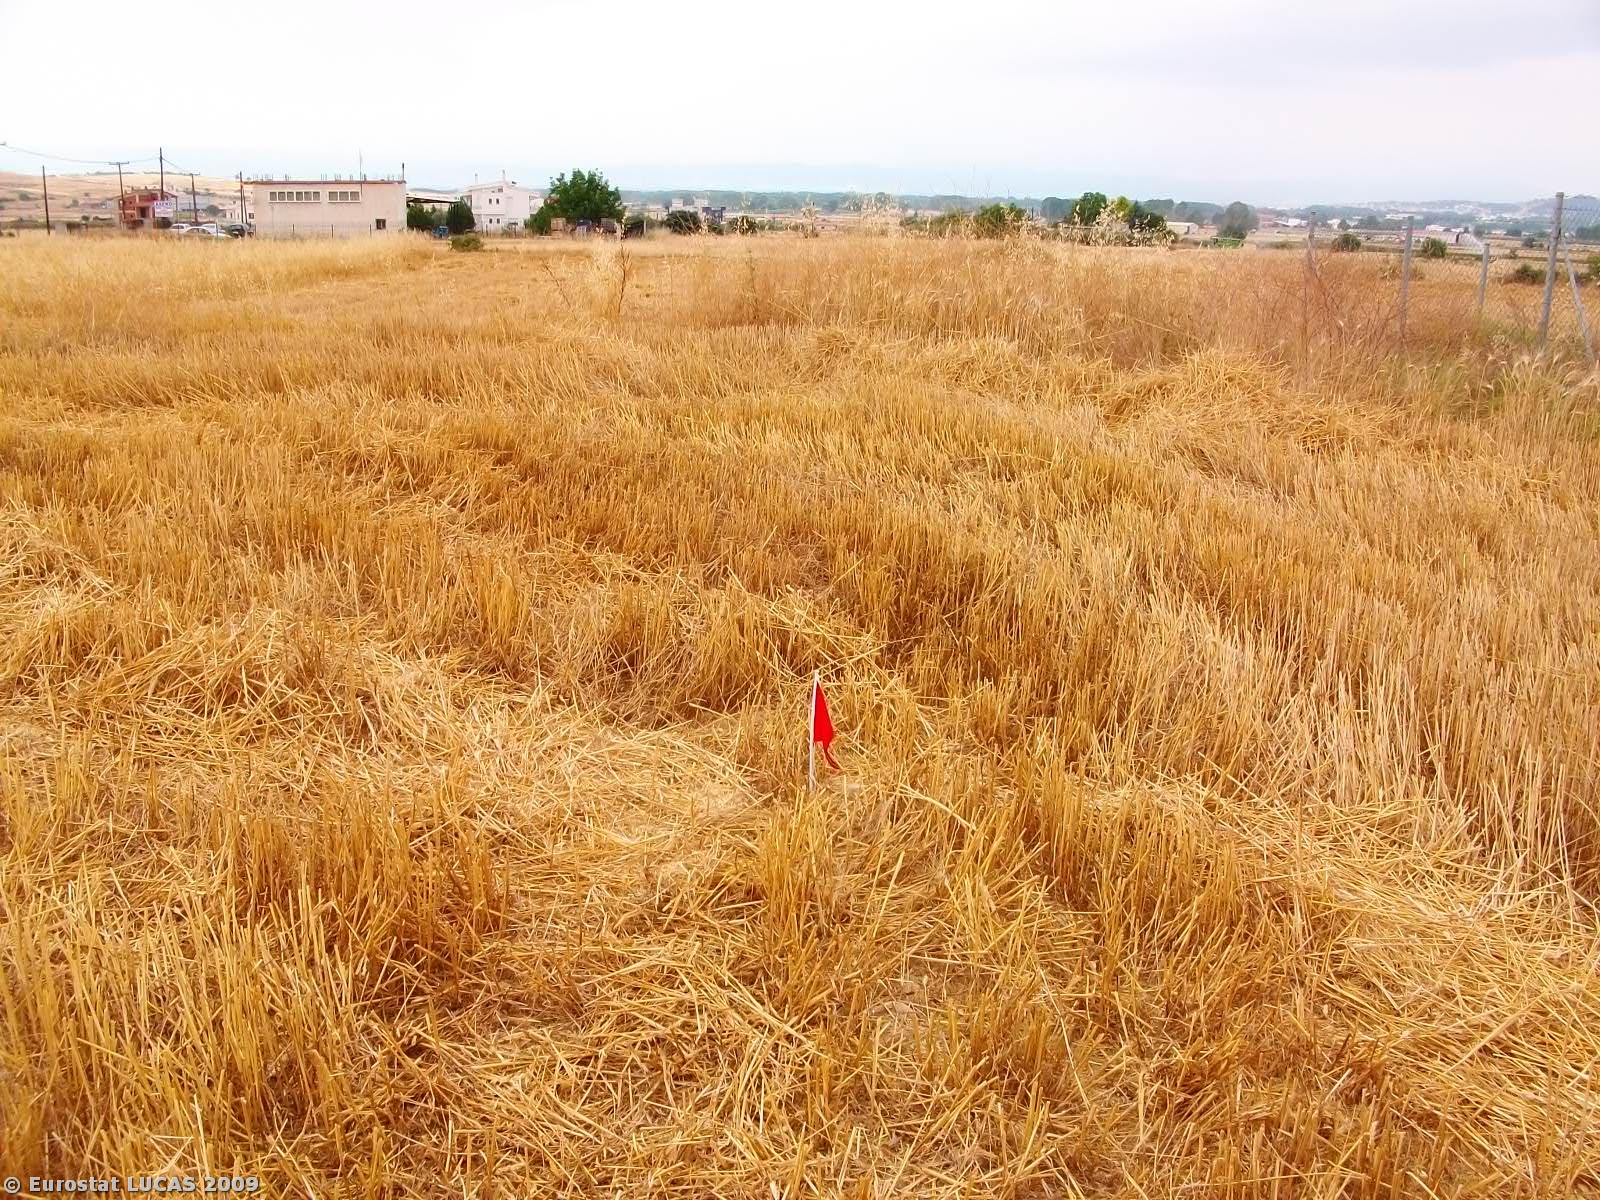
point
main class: Cropland
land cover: Durum wheat
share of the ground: > 75 %
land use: Agriculture (excluding fallow land and kitchen gardens)
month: June
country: GR
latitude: 41.0878
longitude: 23.6277
